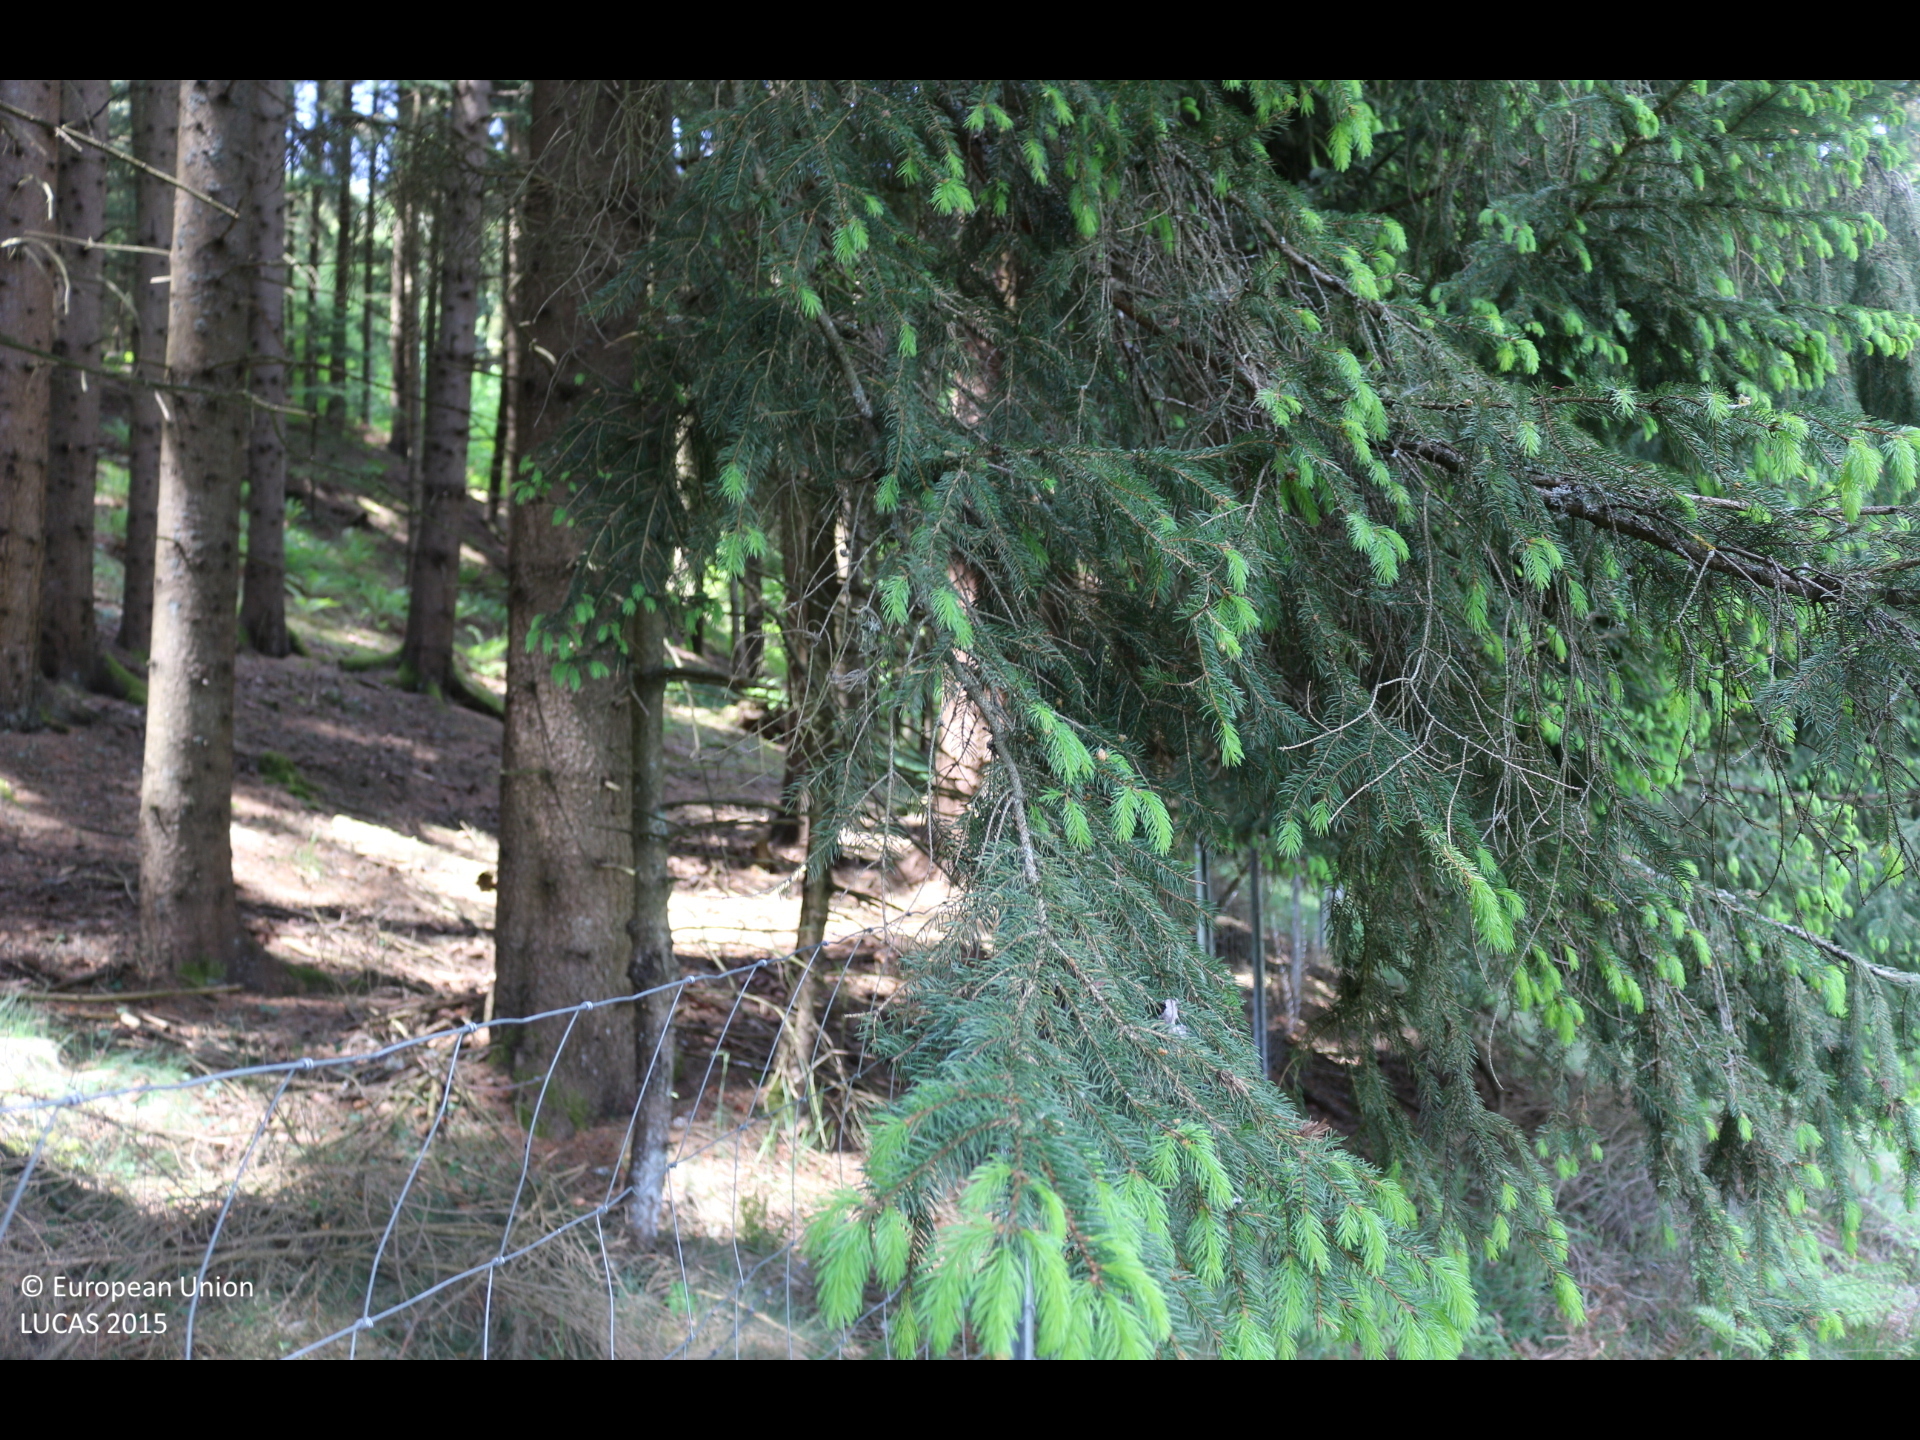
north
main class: Woodland
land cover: Spruce dominated coniferous woodland
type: alpine coniferous forest
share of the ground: > 75 %
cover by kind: coniferous forest trees 100 %
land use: Forestry
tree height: > 5 m
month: May
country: AT
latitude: 46.7706
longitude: 14.2798
